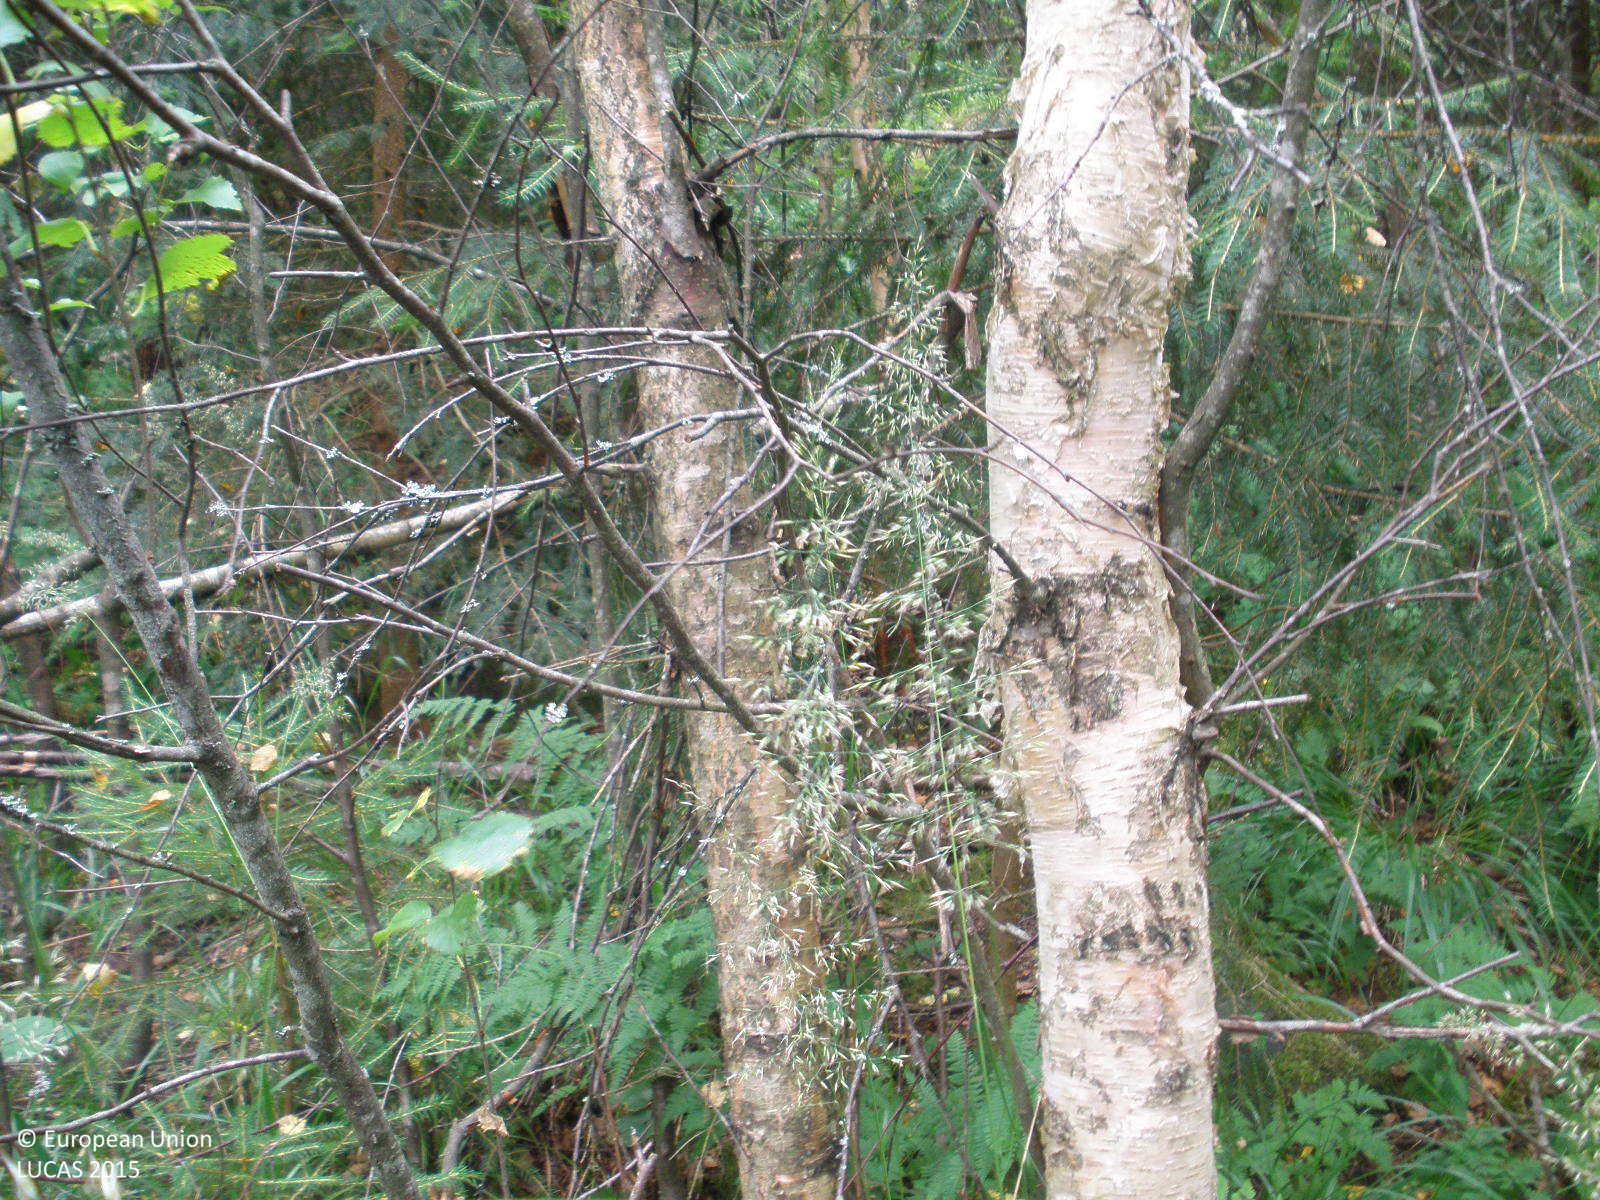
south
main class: Woodland
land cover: Spruce dominated mixed woodland
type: boreal forest
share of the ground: > 75 %
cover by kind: broadleaved forest trees 45 %, coniferous forest trees 30 %, herbaceous plants 15 %, lichens and mosses 10 %
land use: Forestry
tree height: > 5 m
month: August
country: FI
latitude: 60.8031
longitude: 24.4933
